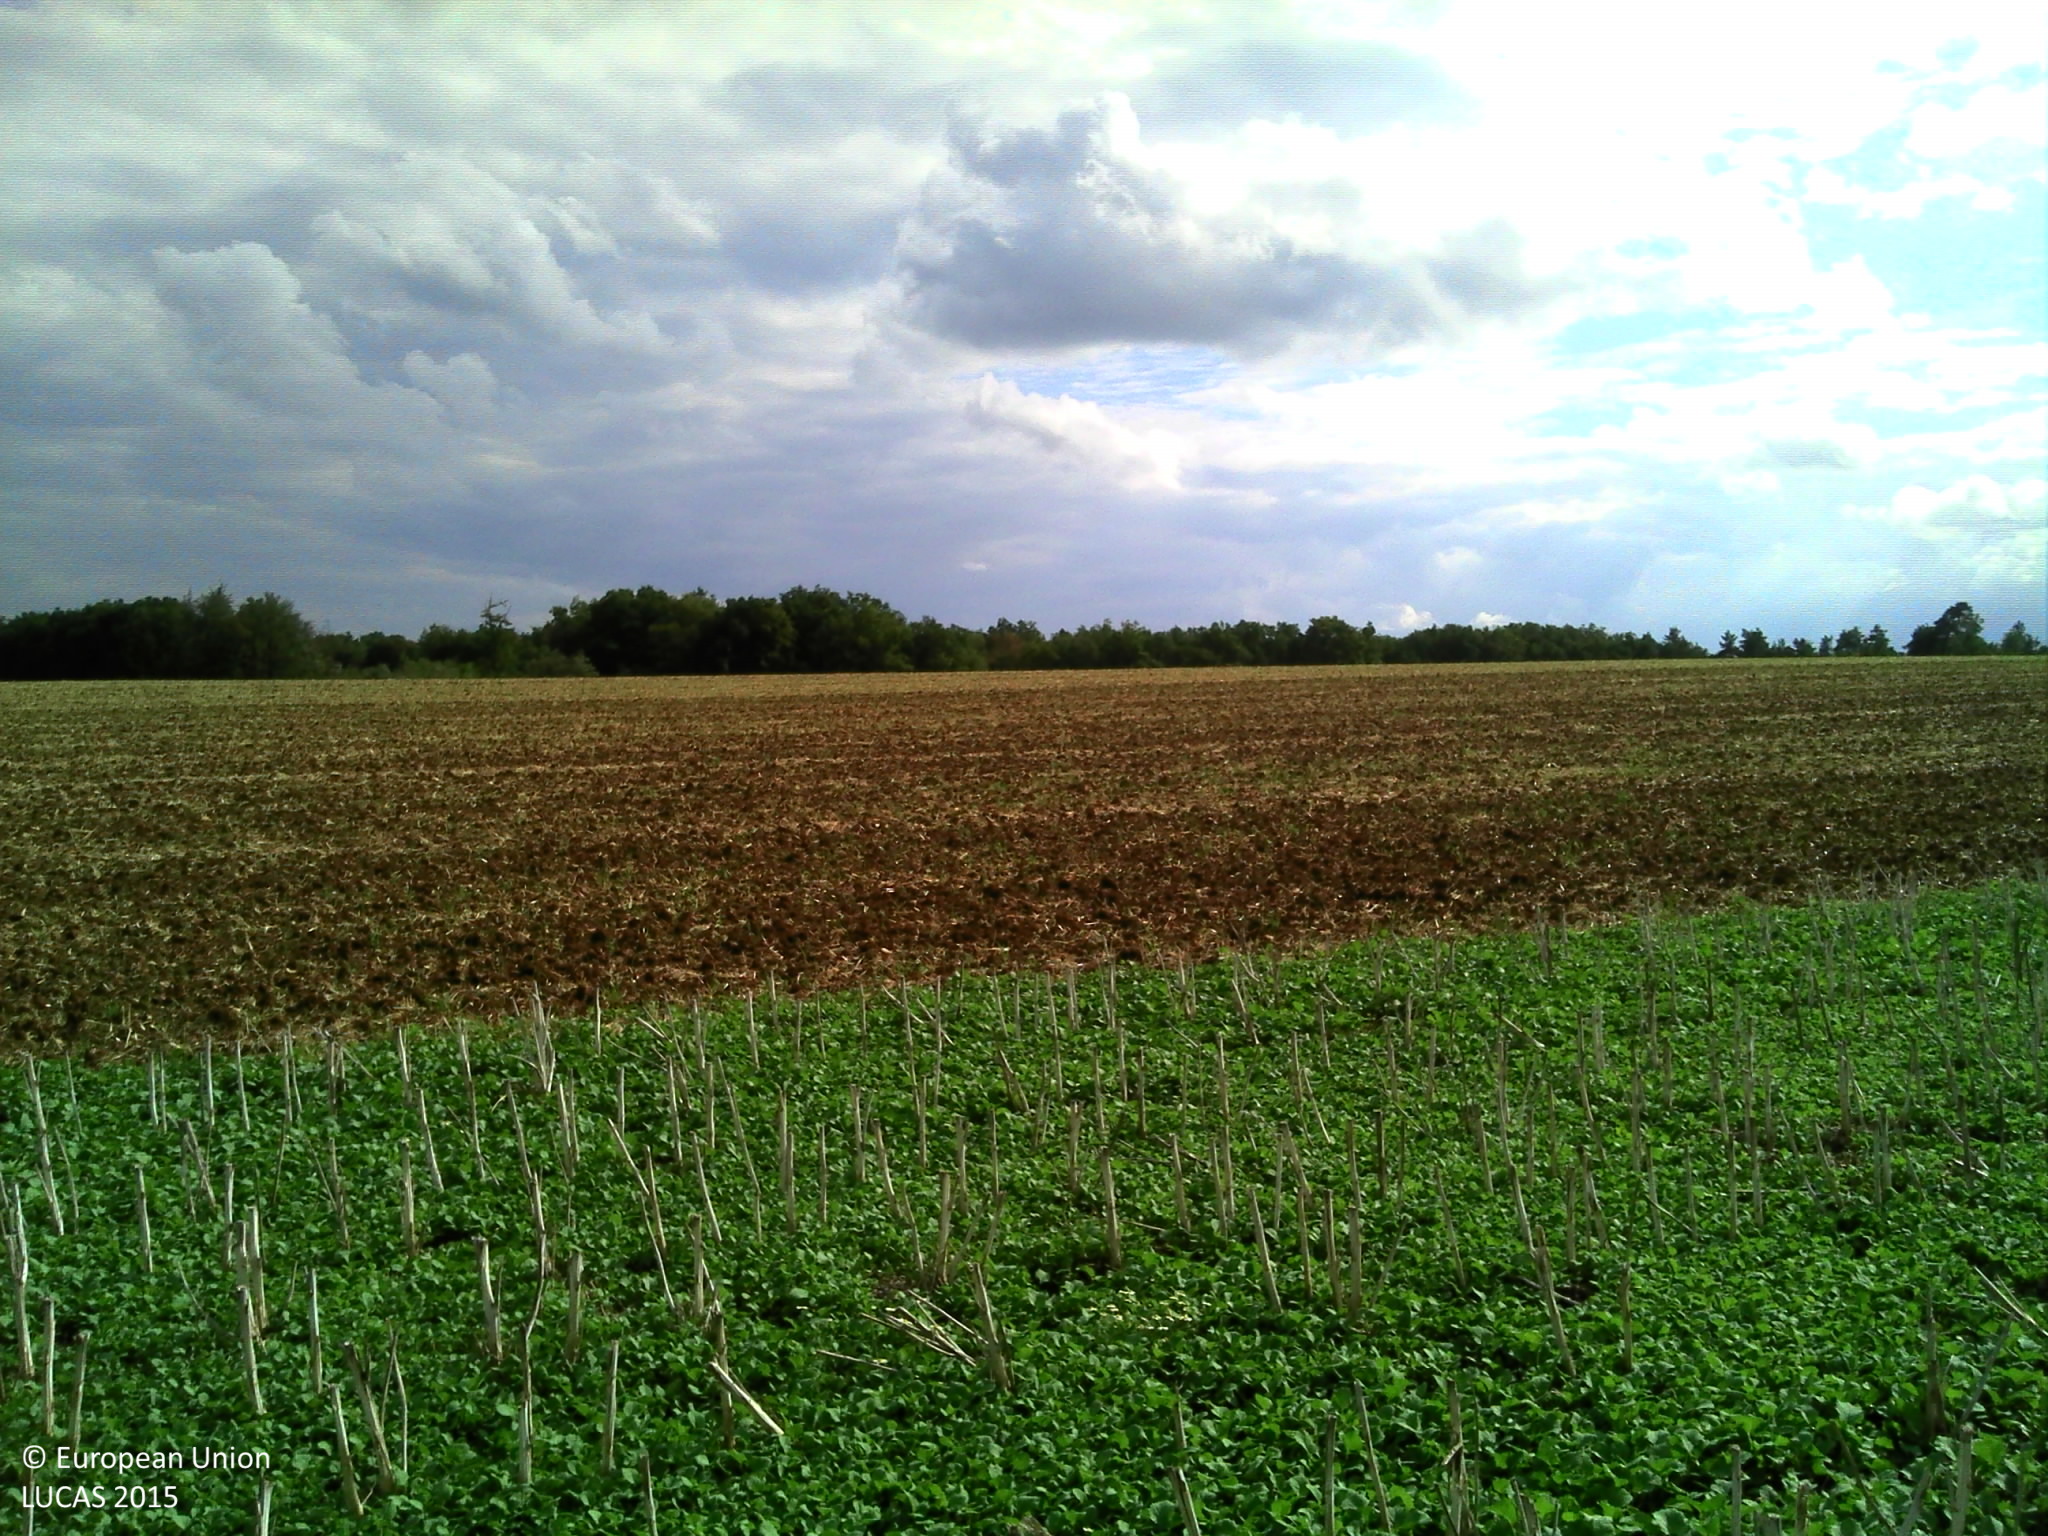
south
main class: Cropland
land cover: Rape and turnip rape
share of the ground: > 75 %
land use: Agriculture (excluding fallow land and kitchen gardens)
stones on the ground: < 10 %
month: September
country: FR
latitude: 47.7722
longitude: 4.3536
